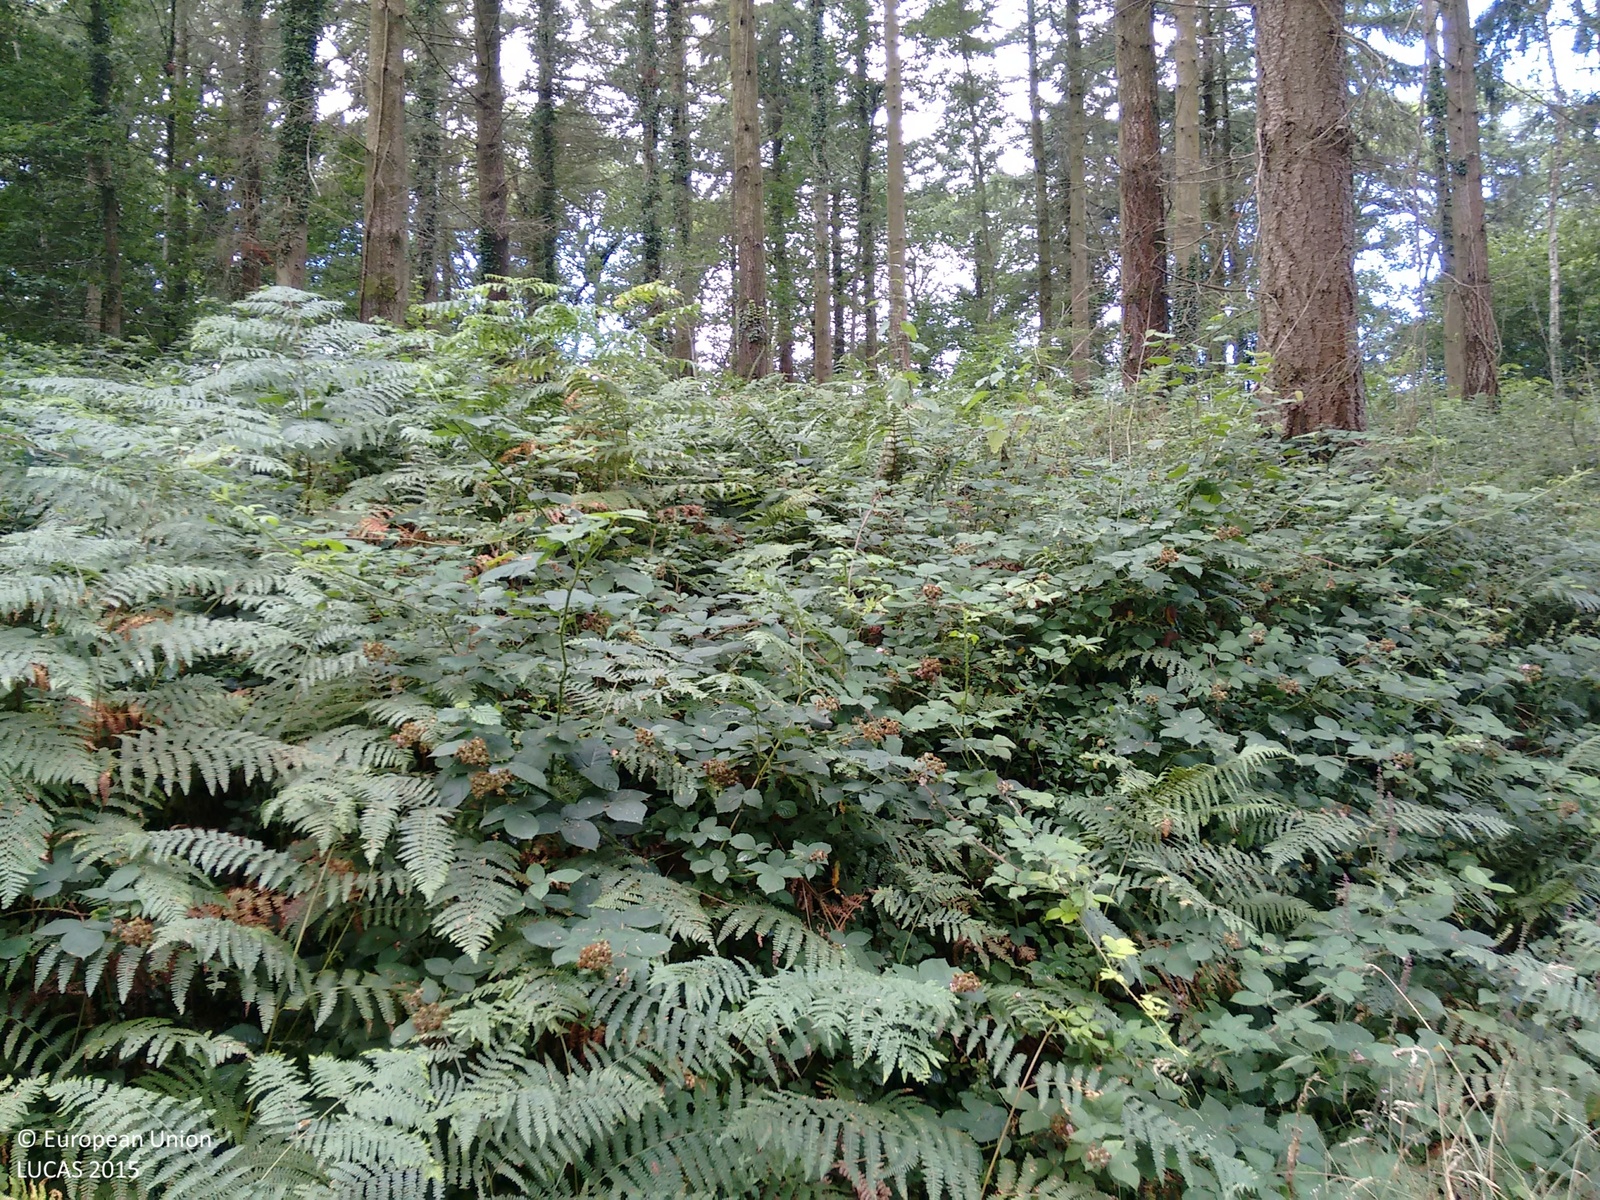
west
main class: Woodland
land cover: Spruce dominated coniferous woodland
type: exotic forest
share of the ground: > 75 %
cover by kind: coniferous forest trees 100 %
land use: Forestry
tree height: > 5 m
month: August
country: GB
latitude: 50.7482
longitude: -3.6215
